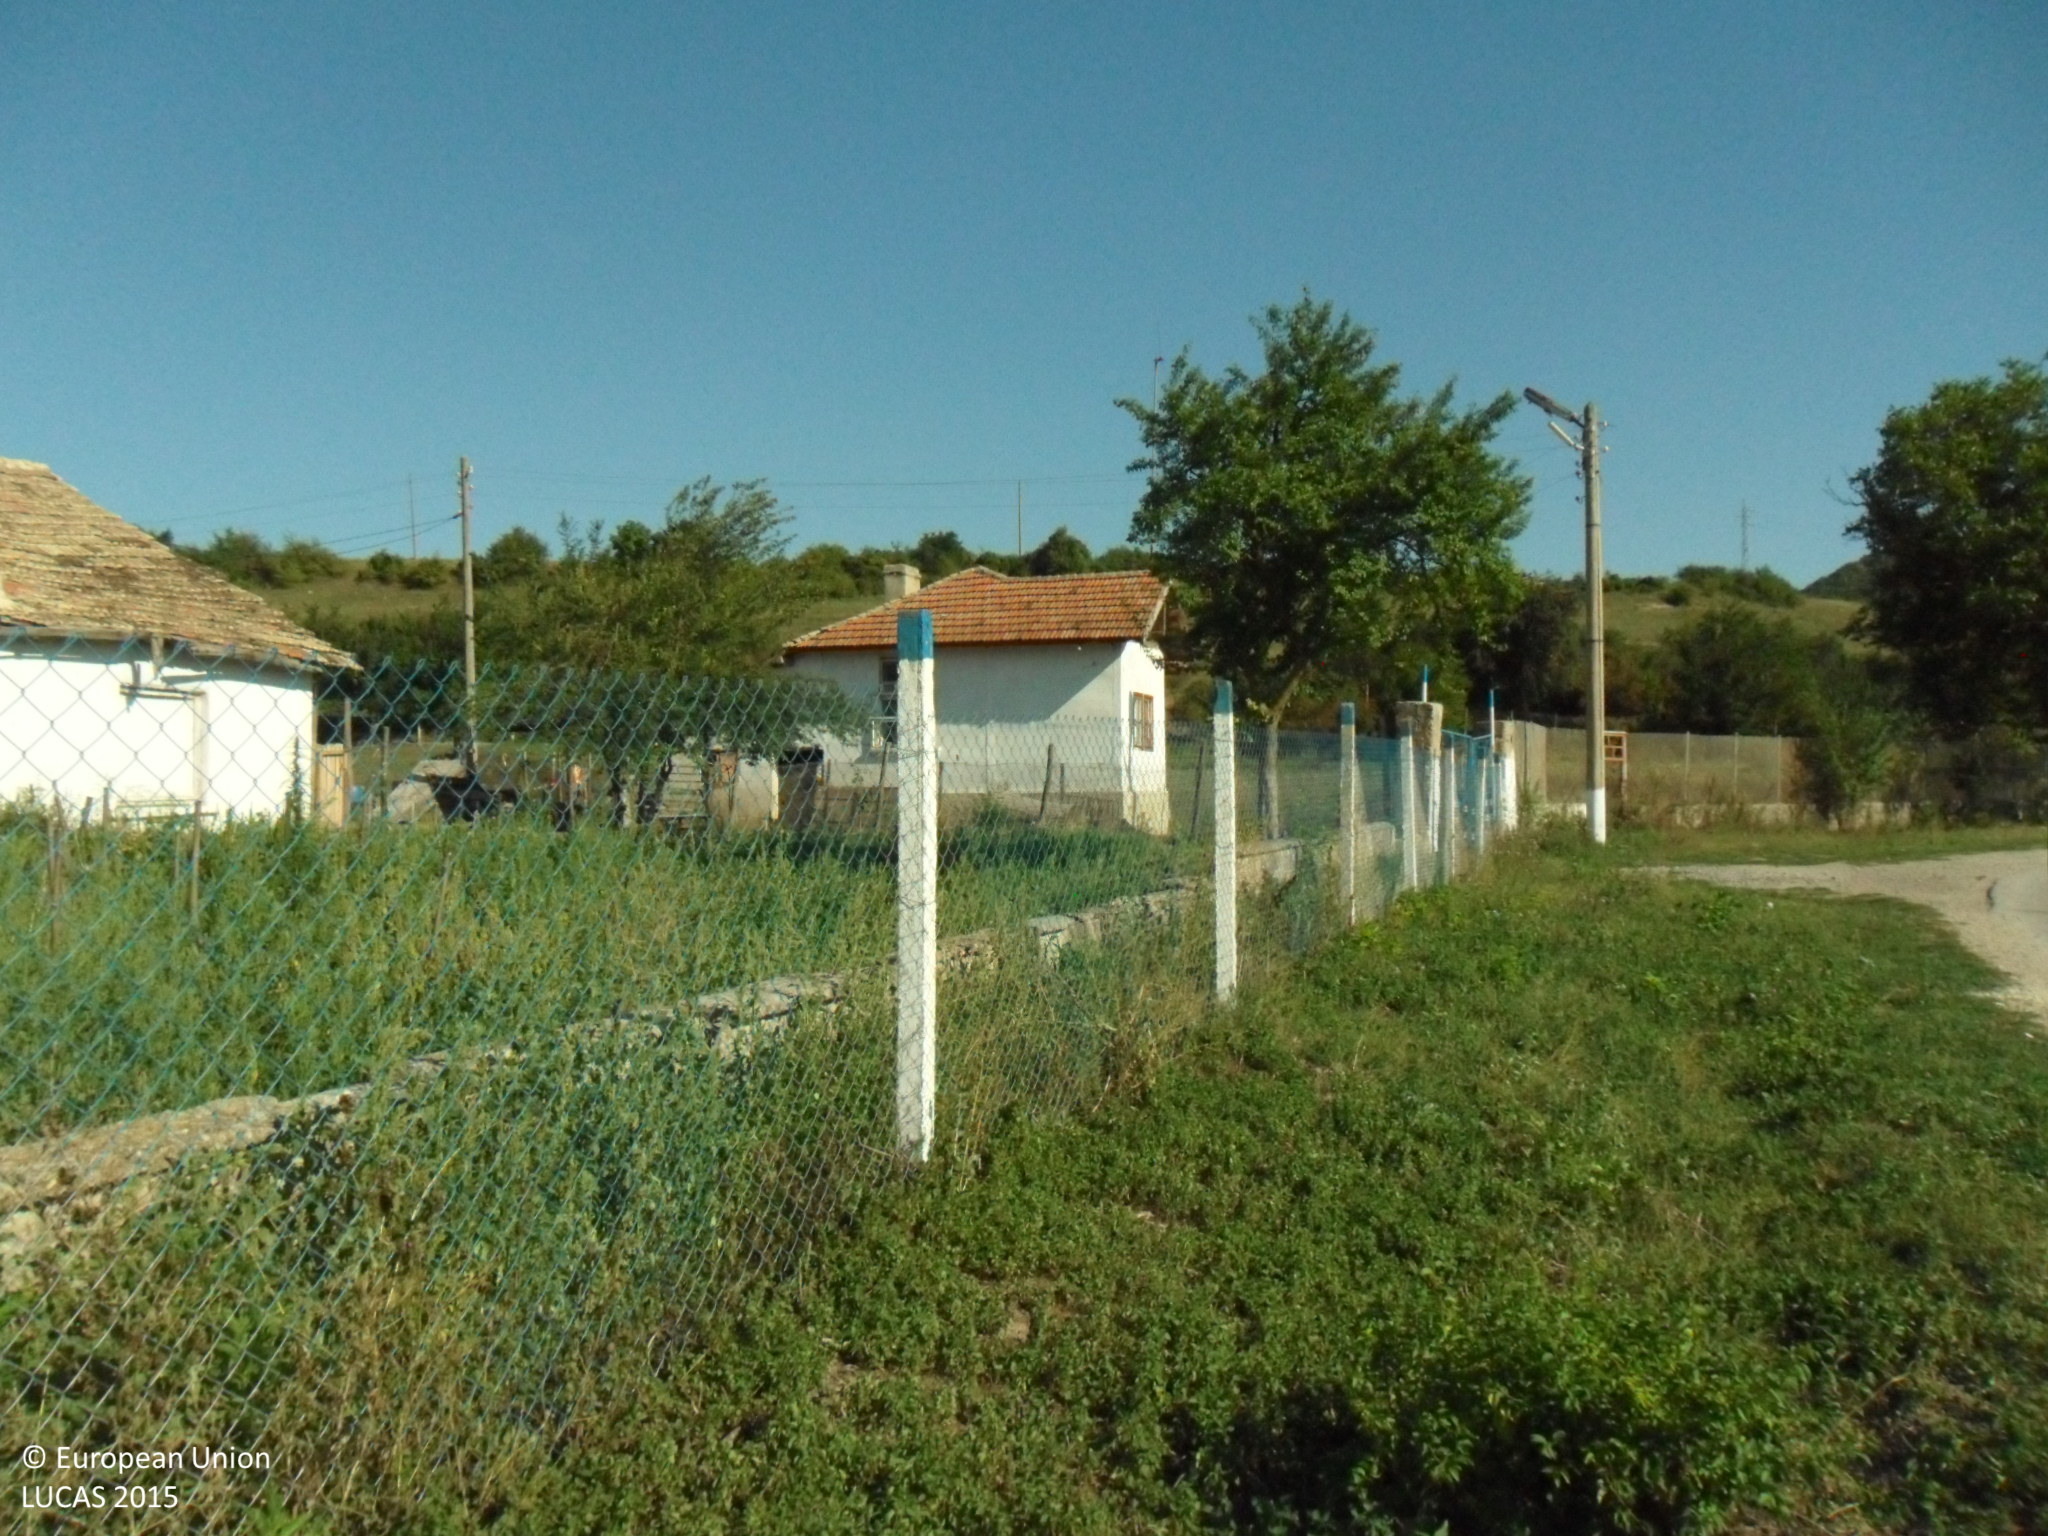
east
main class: Cropland
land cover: Tomatoes
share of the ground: > 75 %
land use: Kitchen garden
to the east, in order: Tomatoes; Artificial constructions in urban areas; Grassland with sparse tree/shrub cover; Lines of trees; Paved roads, cycling and walking lanes; Abandoned hedges; Grassland with sparse tree/shrub cover; Broadleaved woodland; Sunflower; Shrubland with sparse tree cover; Sunflower
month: September
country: BG
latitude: 43.4770
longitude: 27.1699
